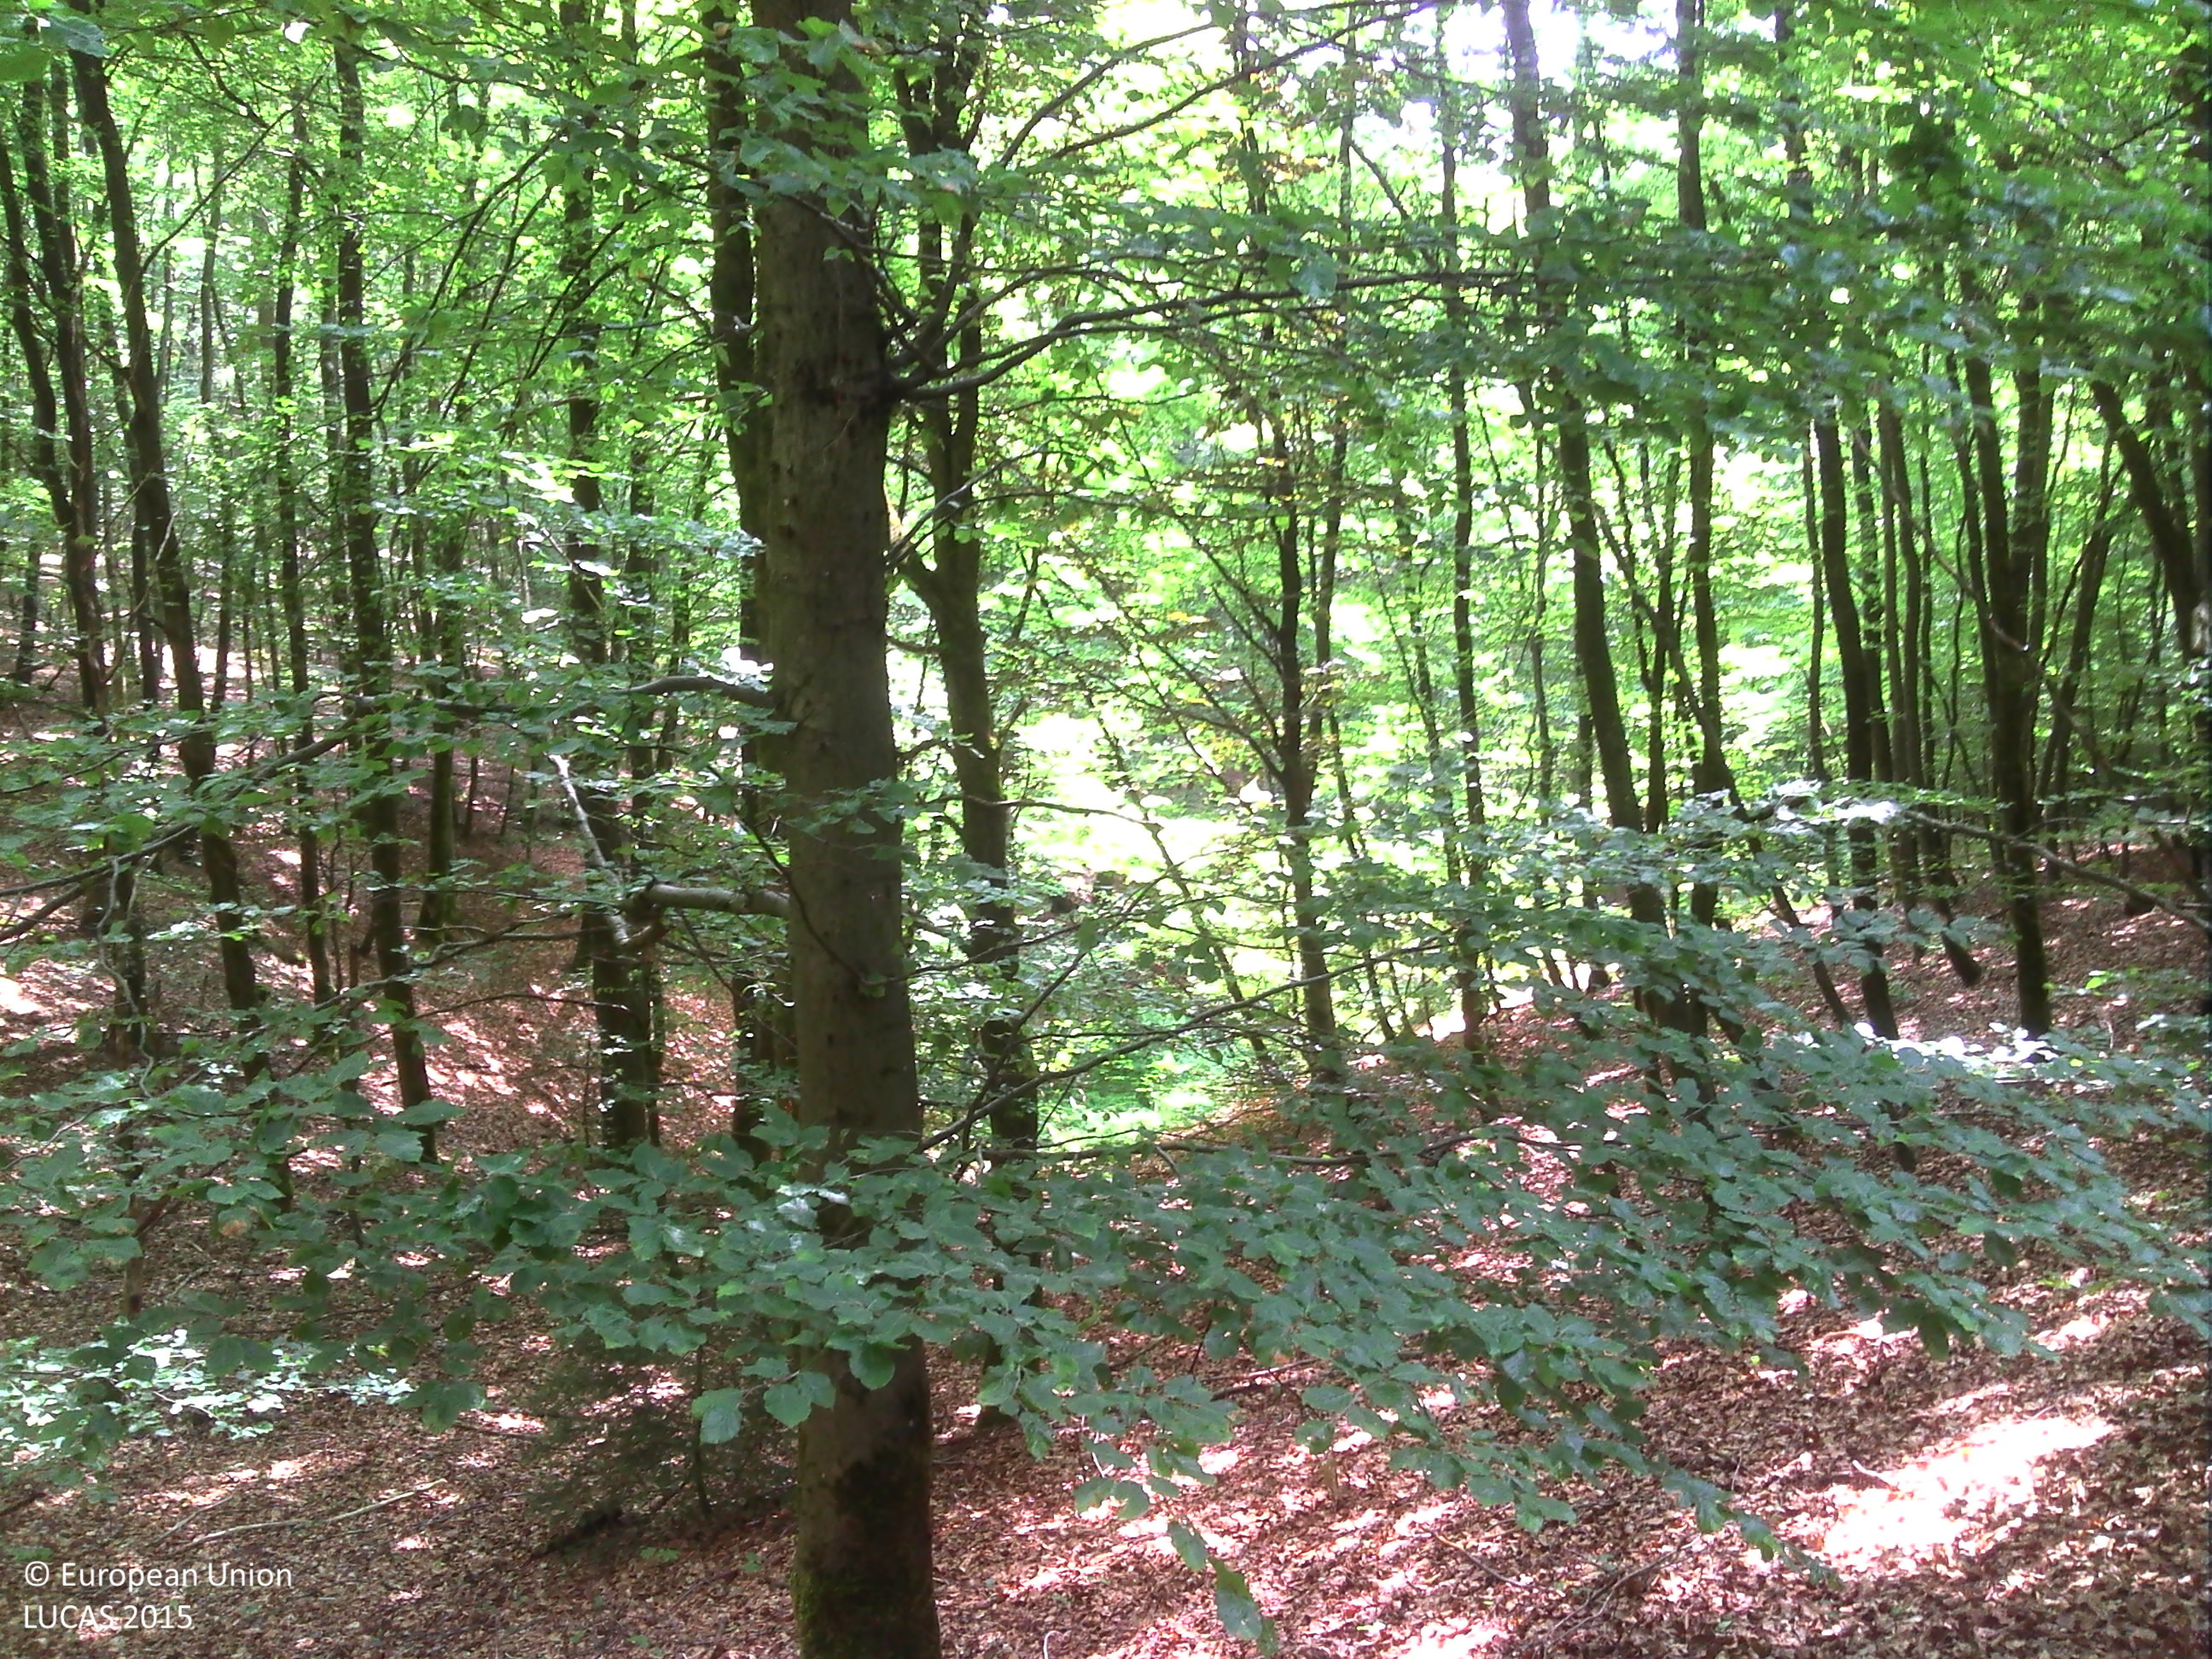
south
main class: Woodland
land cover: Broadleaved woodland
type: beech forest
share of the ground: > 75 %
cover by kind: broadleaved forest trees 100 %
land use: Forestry
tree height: > 5 m
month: June
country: BE
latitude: 50.3924
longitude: 6.2436
